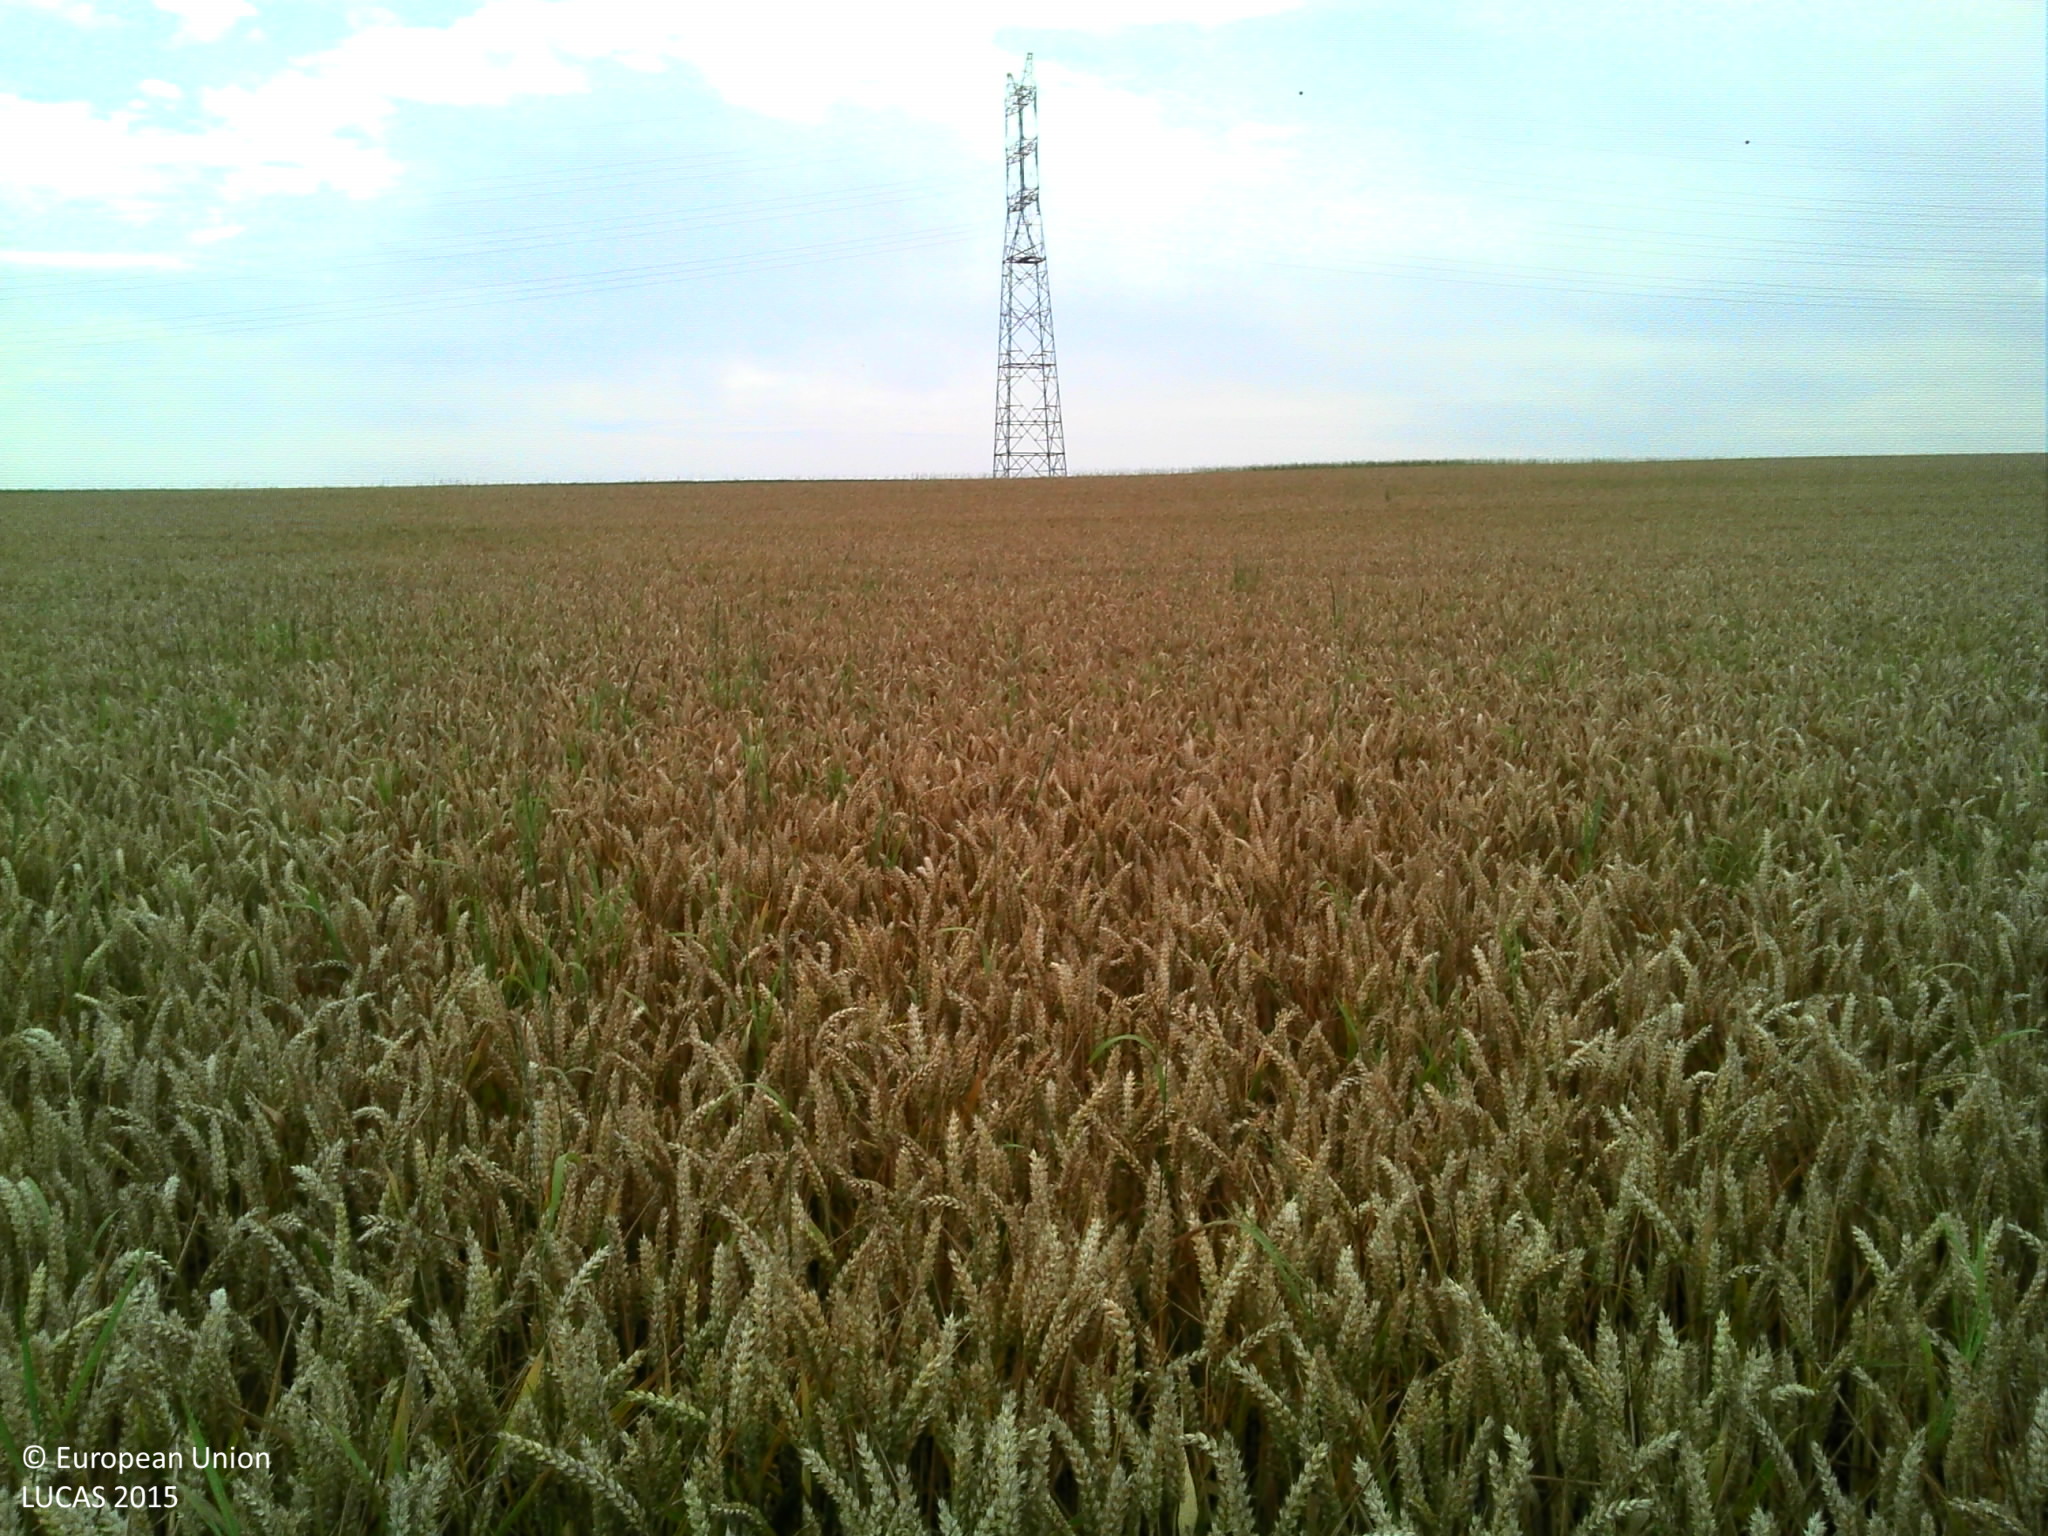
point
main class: Cropland
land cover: Common wheat
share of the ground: > 75 %
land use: Agriculture (excluding fallow land and kitchen gardens)
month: July
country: BE
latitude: 50.5303
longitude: 4.3383
